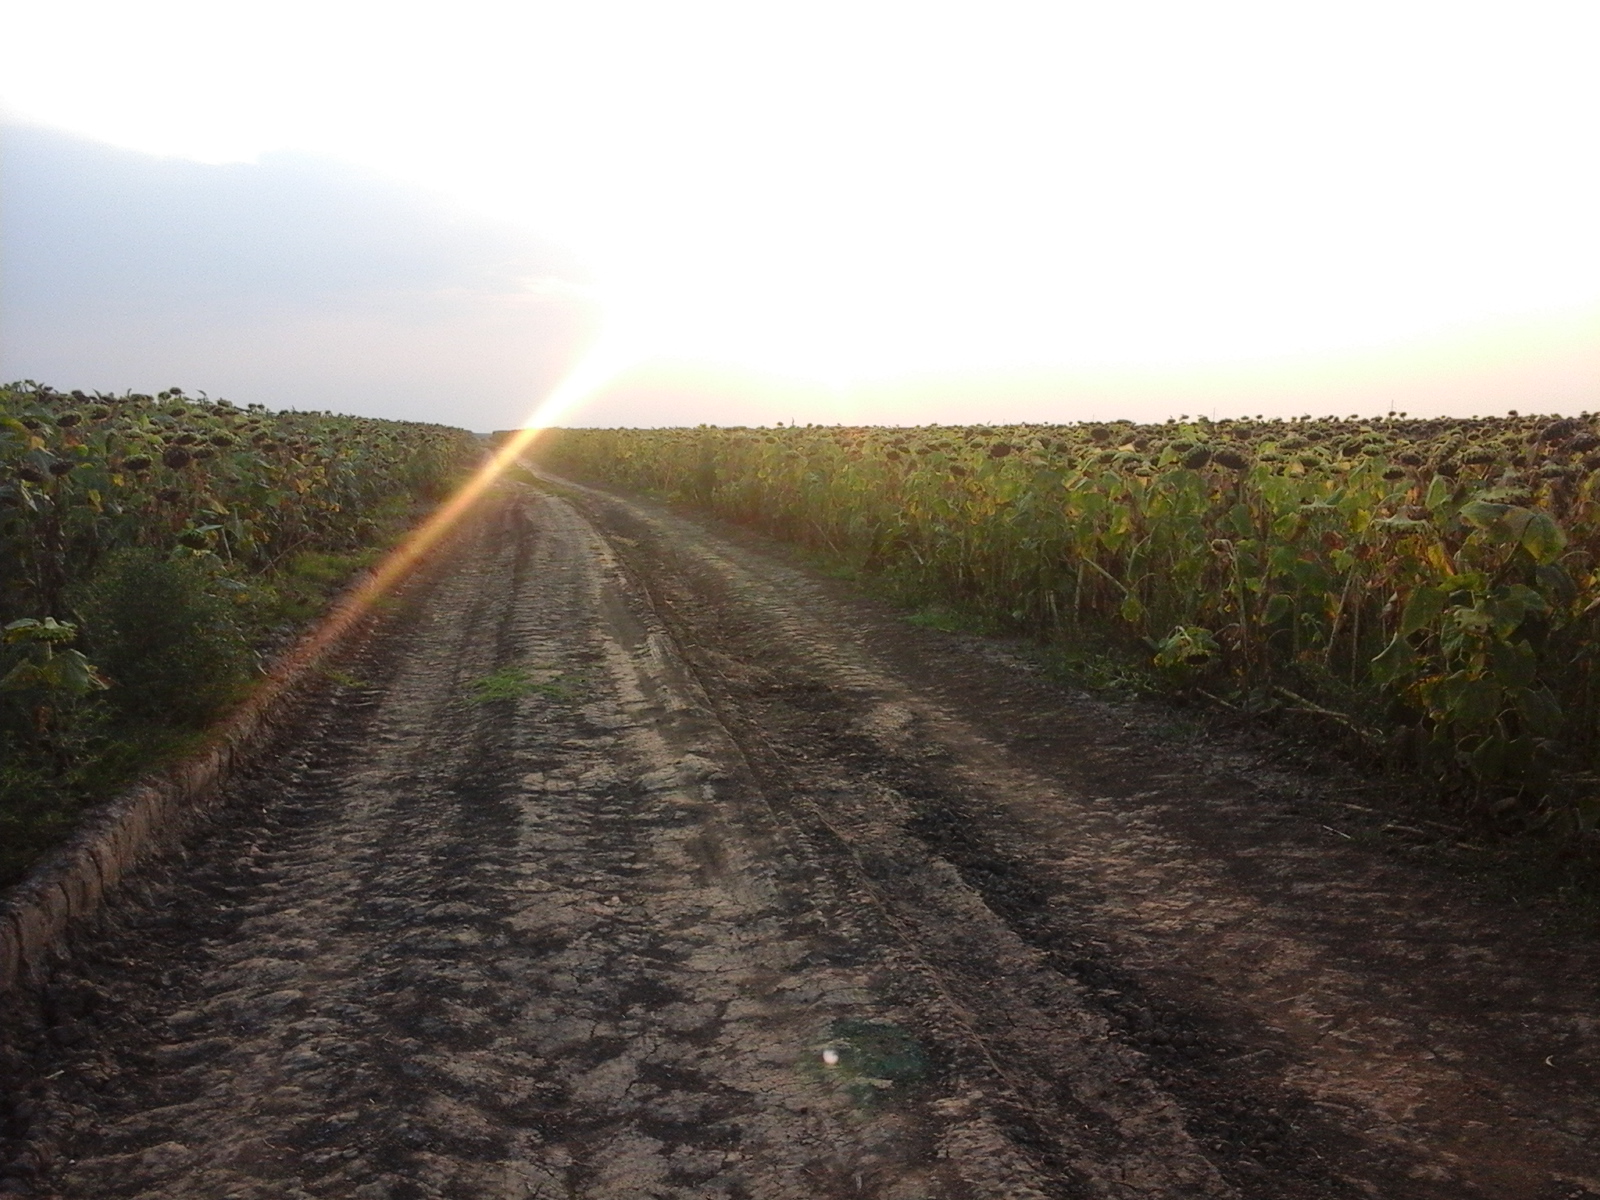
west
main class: Cropland
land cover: Sunflower
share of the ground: > 75 %
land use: Agriculture (excluding fallow land and kitchen gardens)
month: August
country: RO
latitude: 44.0428
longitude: 23.2619
